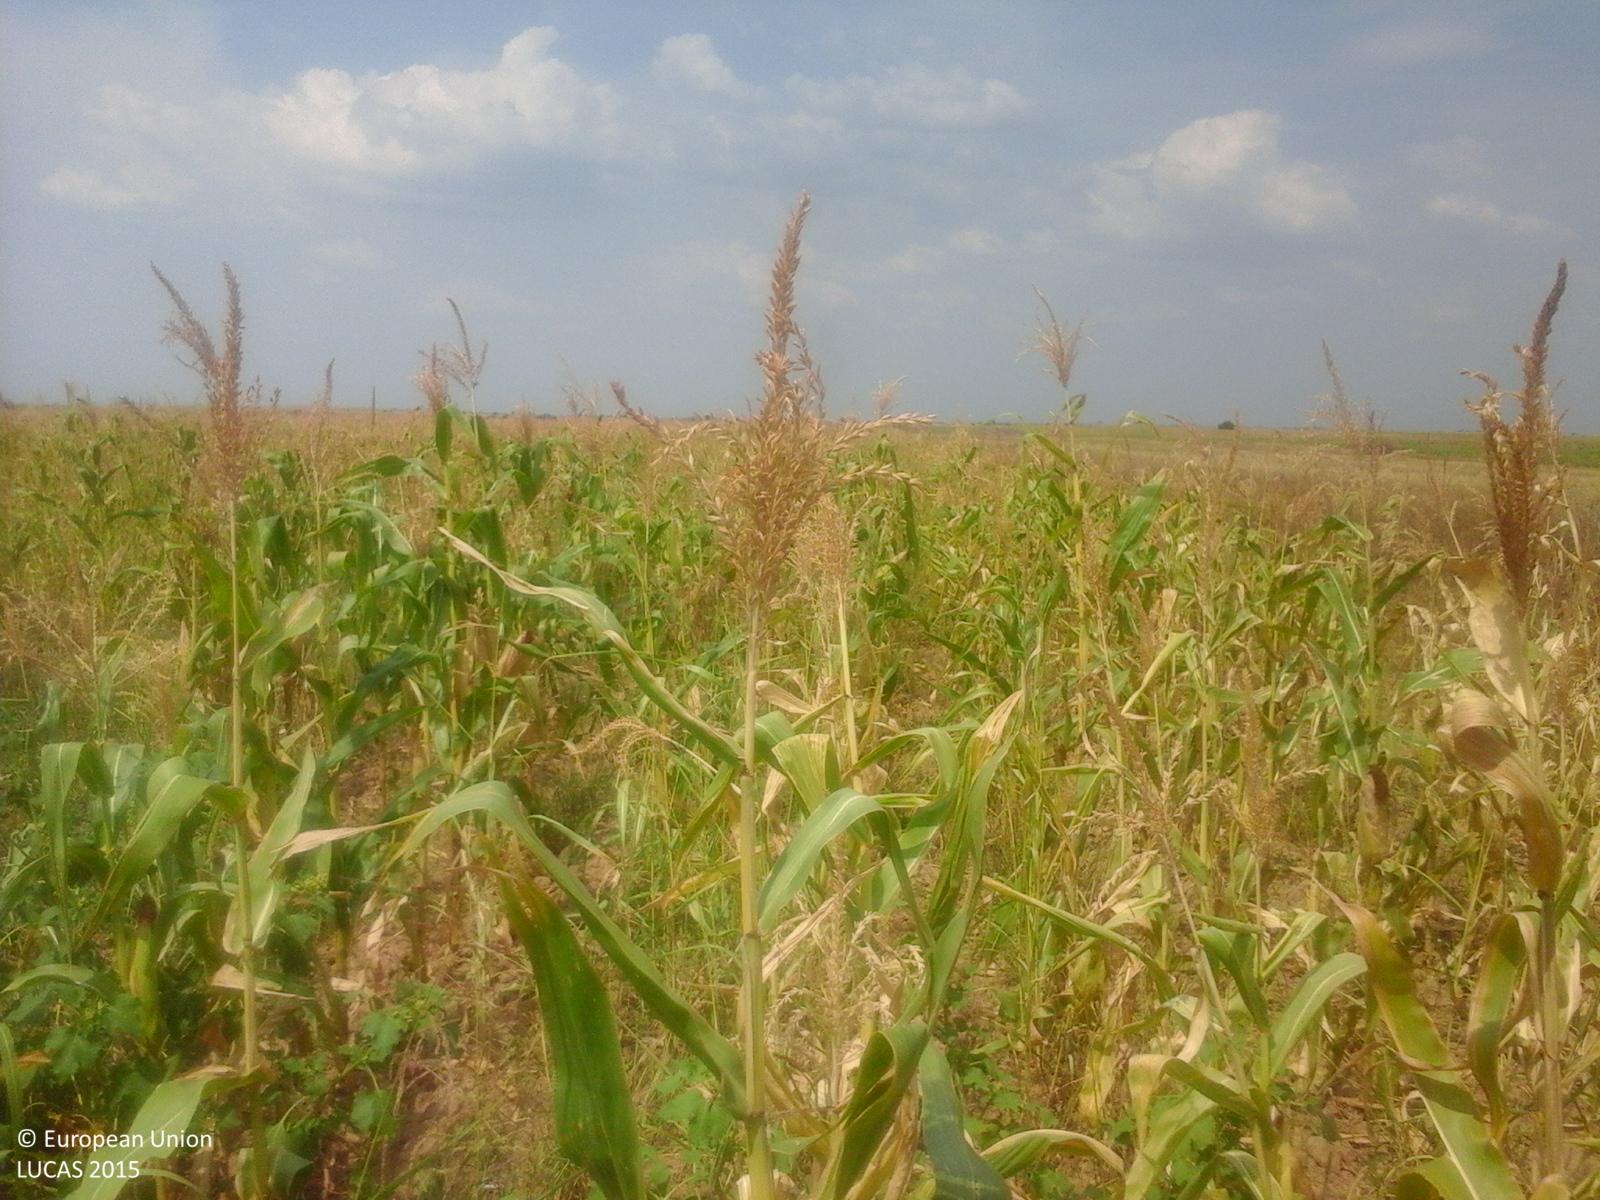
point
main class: Cropland
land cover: Maize
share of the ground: > 75 %
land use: Agriculture (excluding fallow land and kitchen gardens)
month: August
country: RO
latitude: 44.3212
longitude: 22.7929
